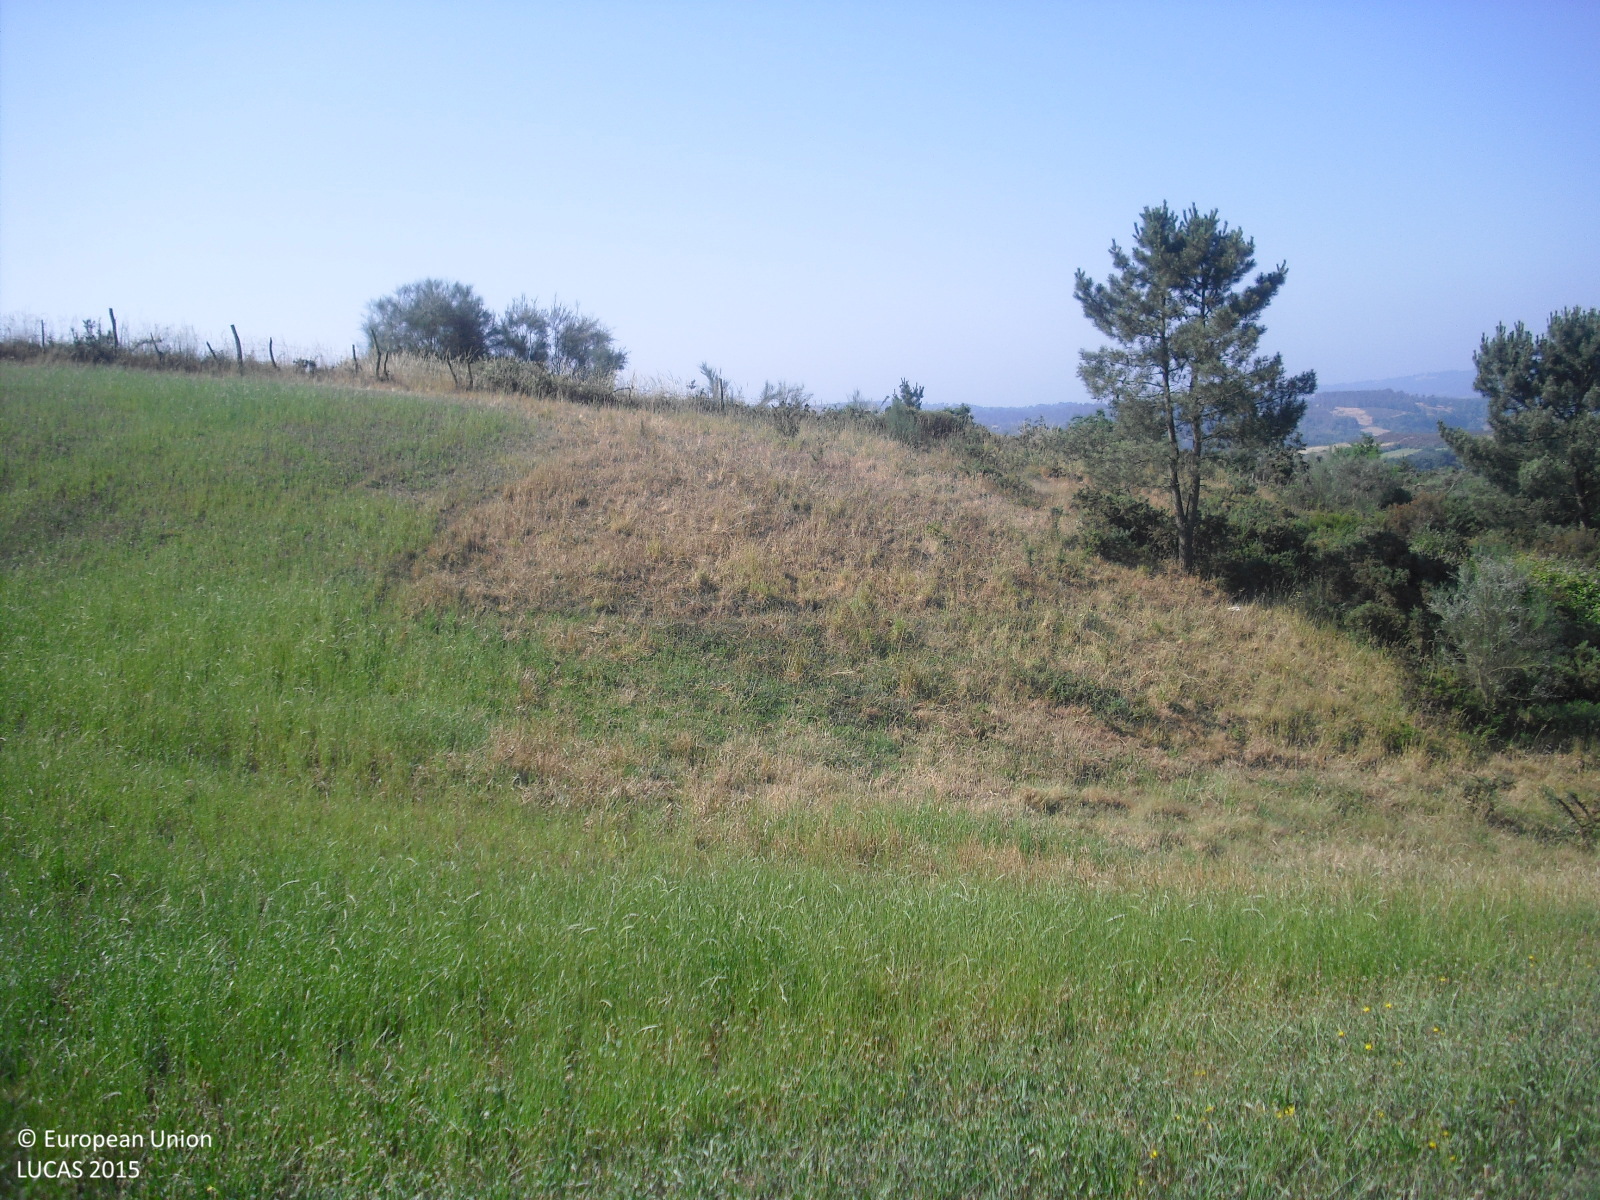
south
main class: Cropland
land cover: Temporary grasslands
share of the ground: > 75 %
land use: Agriculture (excluding fallow land and kitchen gardens)
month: June
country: ES
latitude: 42.5476
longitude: -7.7465
